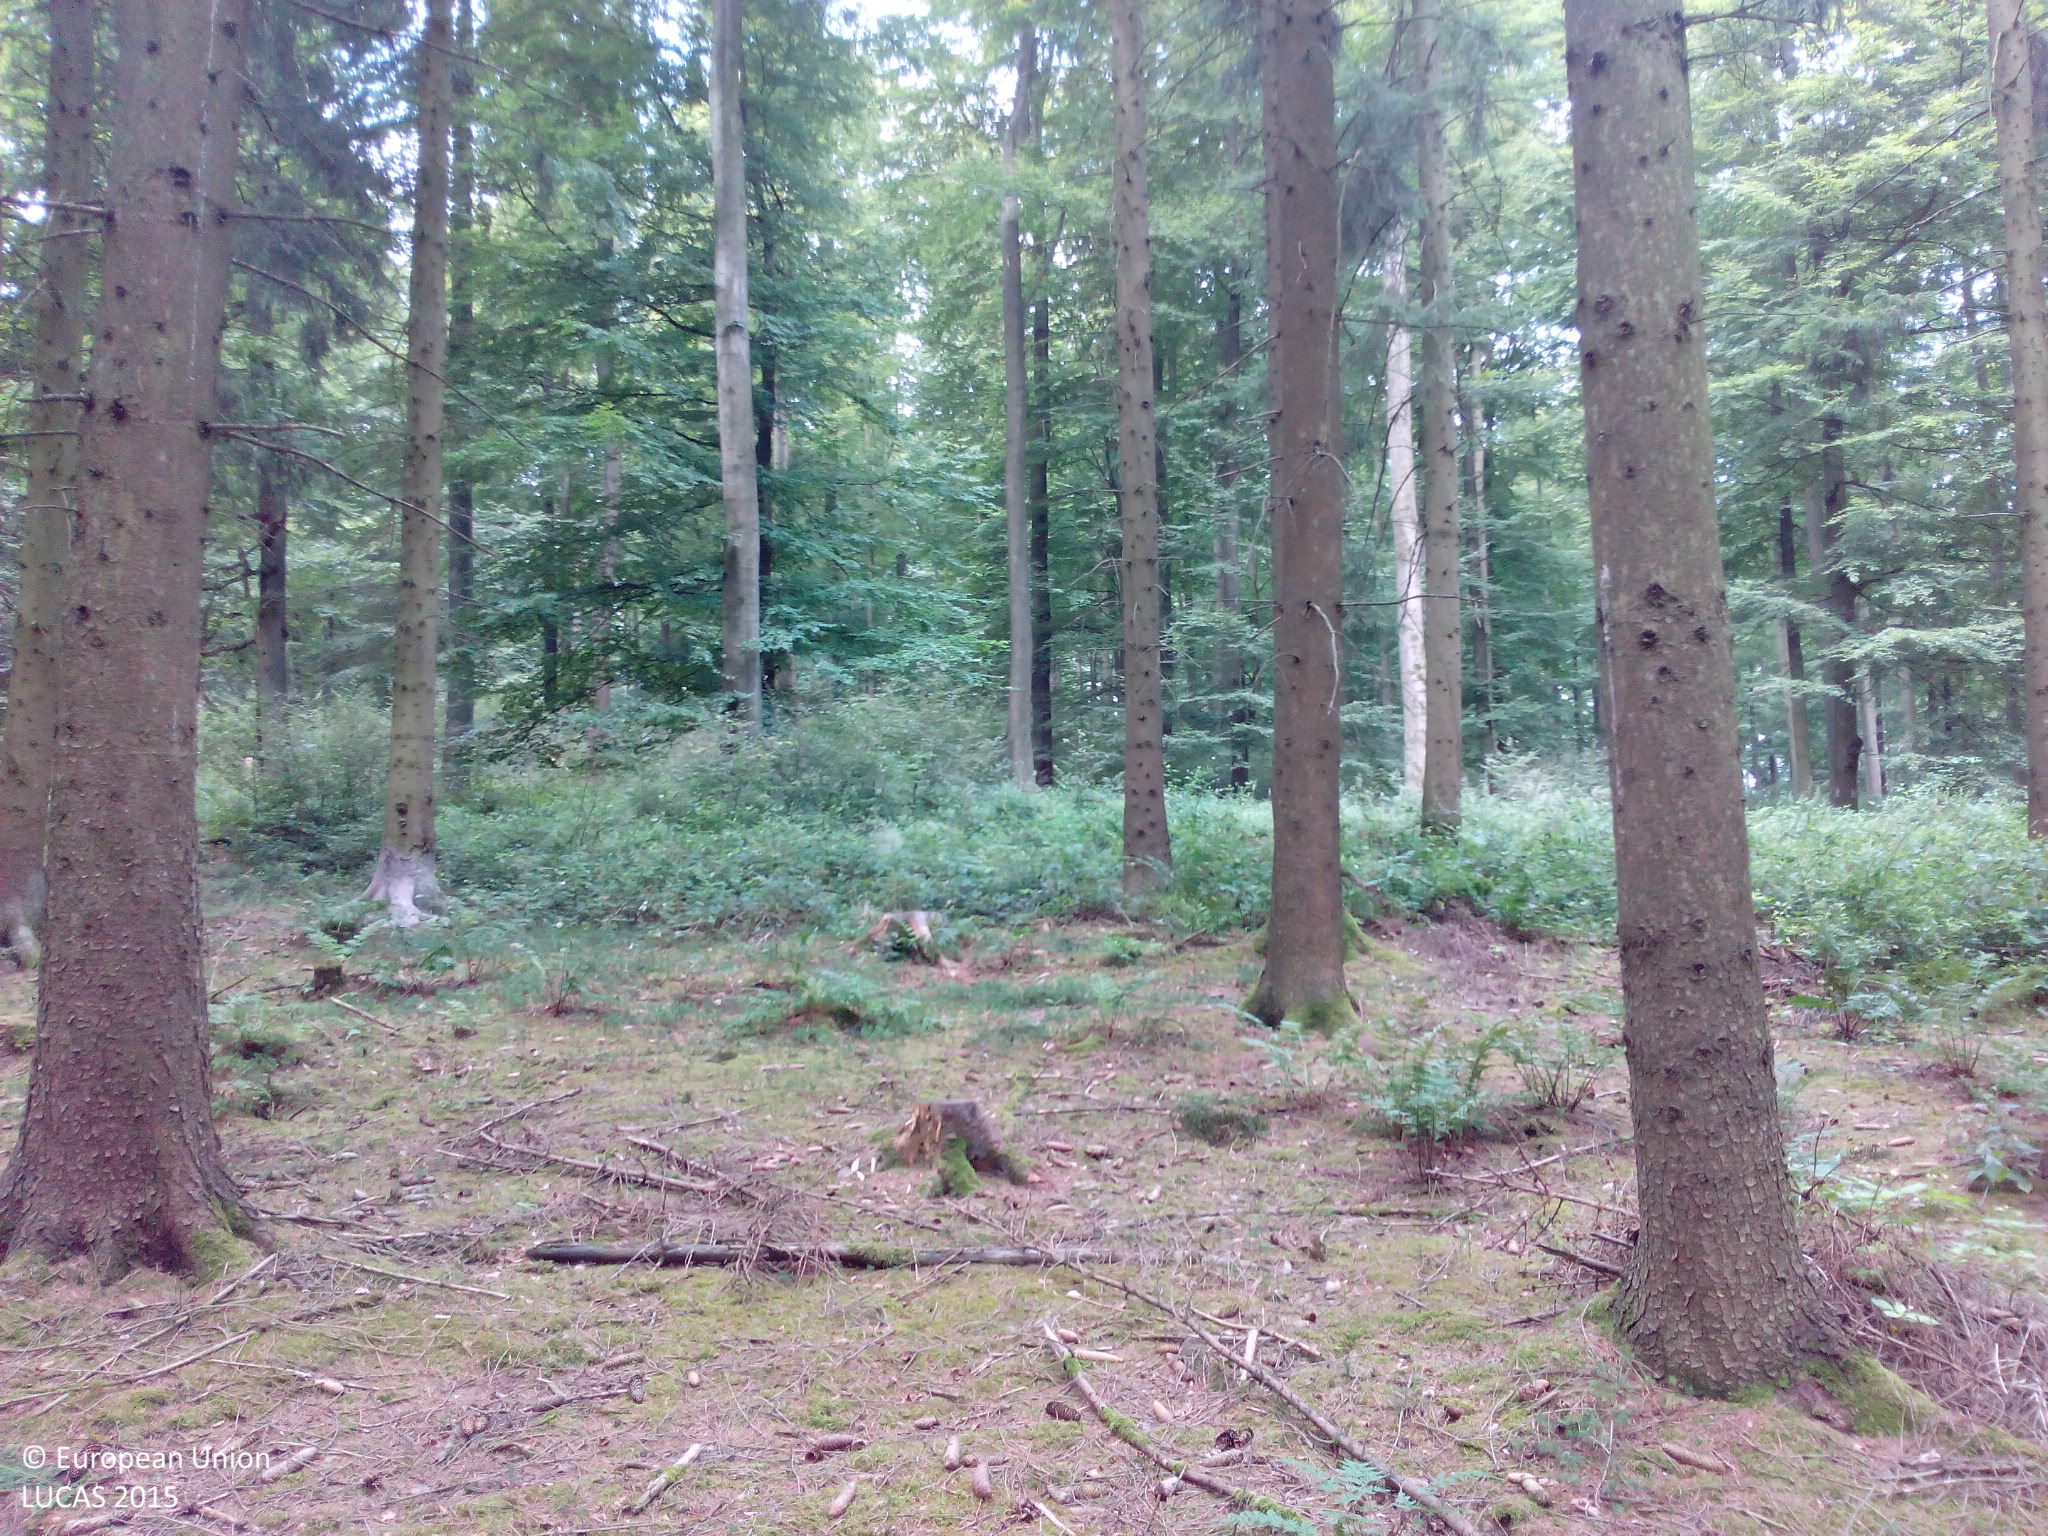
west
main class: Woodland
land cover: Spruce dominated coniferous woodland
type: hemiboreal forest and nemoral coniferous forest and mixed broadleaved-coniferous forest
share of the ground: > 75 %
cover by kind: coniferous forest trees 95 %, herbaceous plants 5 %
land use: Forestry
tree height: > 5 m
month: August
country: DE
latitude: 52.0158
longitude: 9.2863
